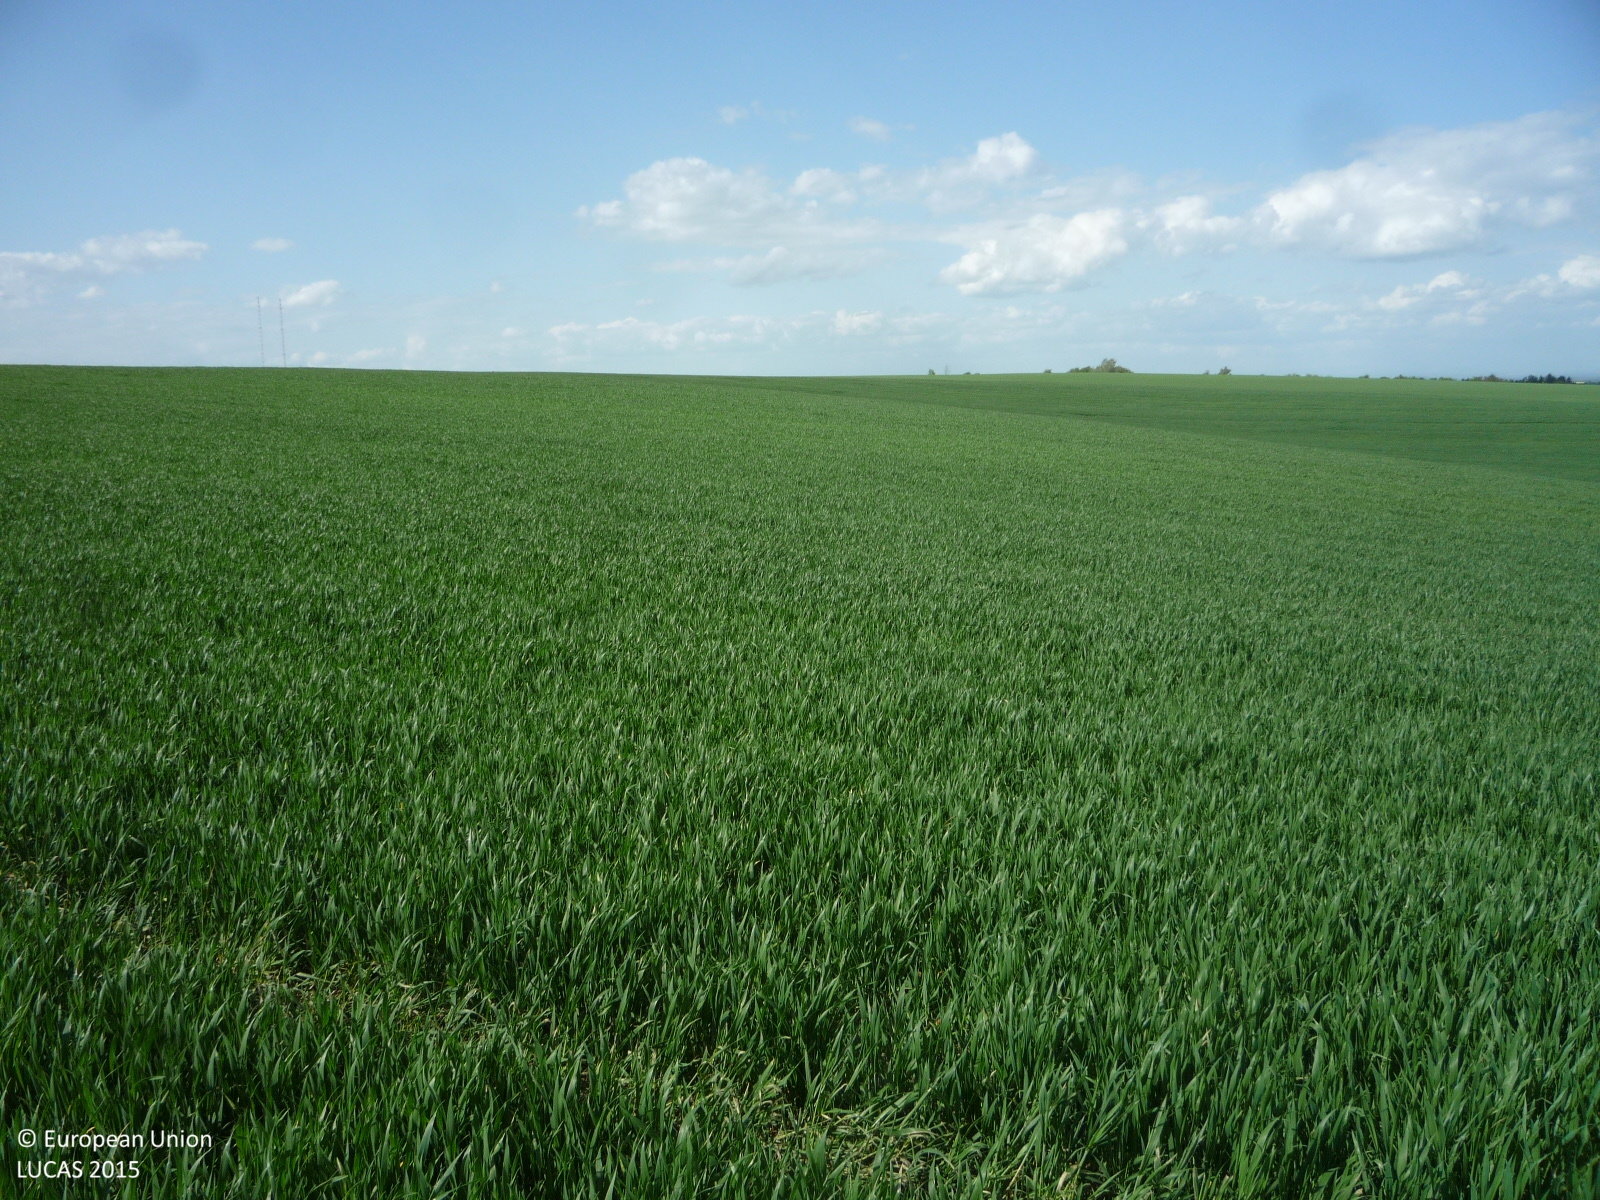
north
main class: Cropland
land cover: Common wheat
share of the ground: > 75 %
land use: Agriculture (excluding fallow land and kitchen gardens)
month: May
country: CZ
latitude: 50.0248
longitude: 14.9019
